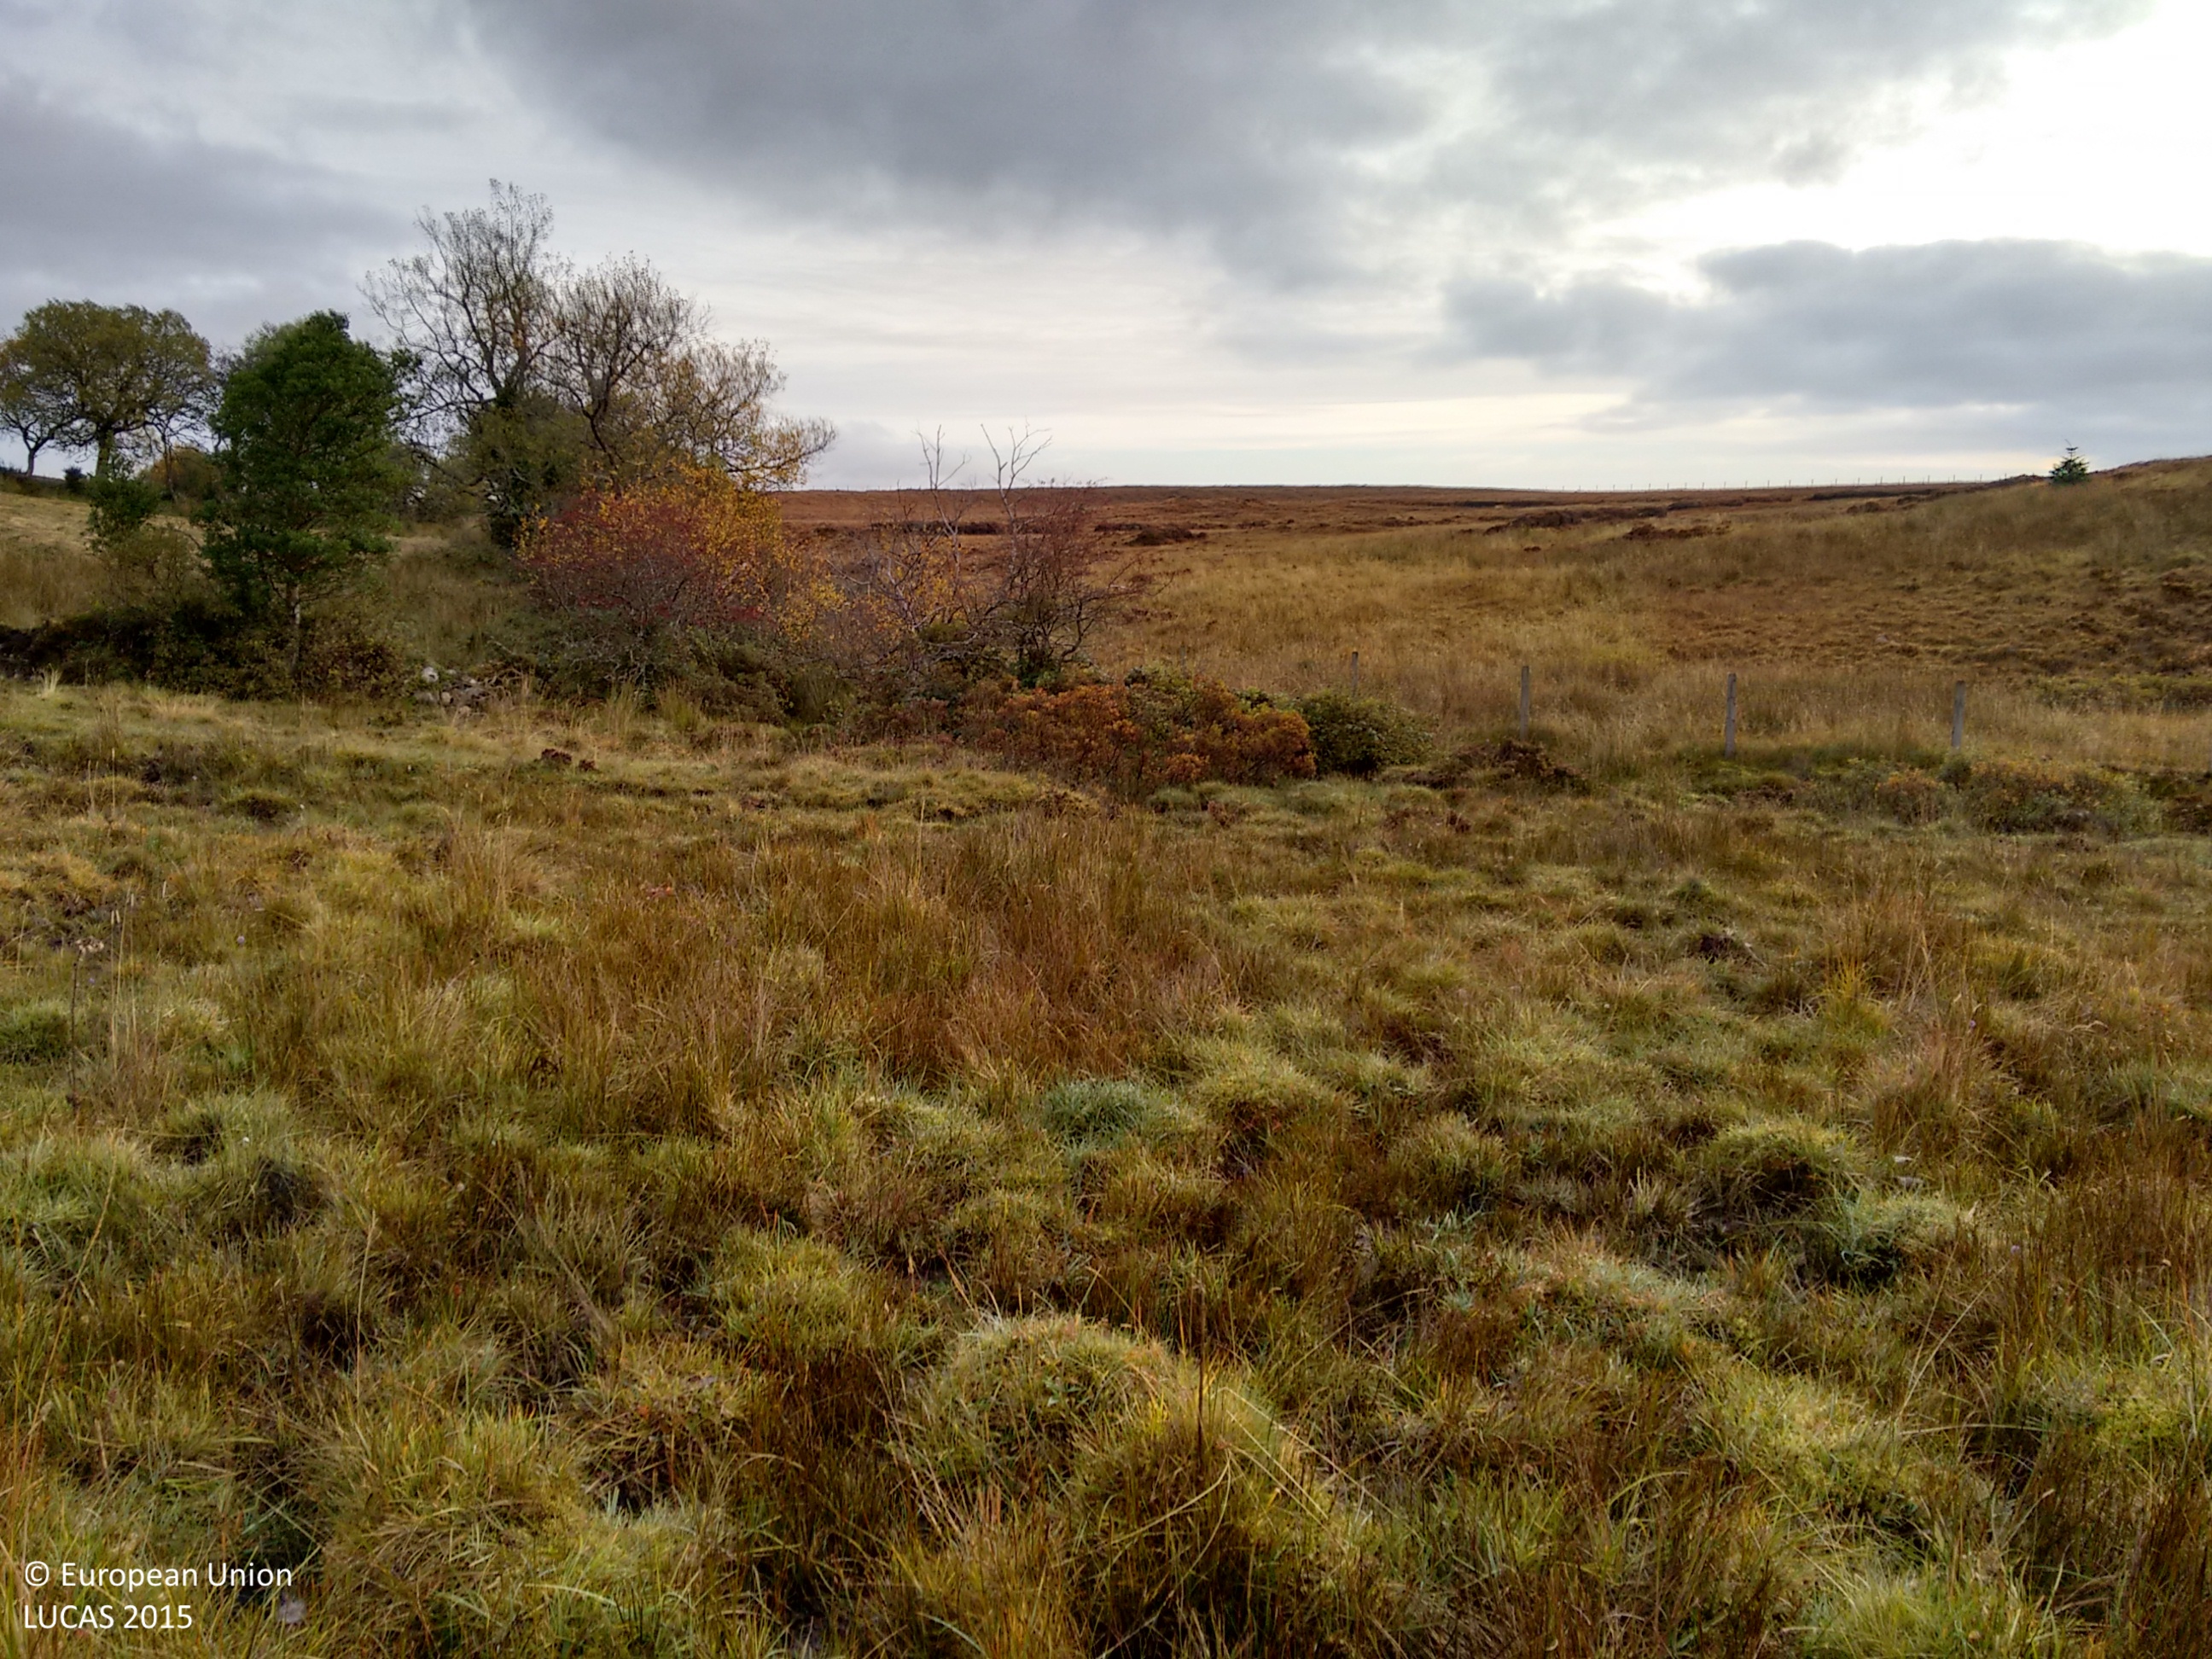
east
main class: Grassland
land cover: Grassland without tree/shrub cover
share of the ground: > 75 %
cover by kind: herbaceous plants 100 %
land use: Agriculture (excluding fallow land and kitchen gardens)
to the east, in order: Grassland without tree/shrub cover; Fences; Ditches and canals; Grass margins; Fences; Grassland without tree/shrub cover; Fences; Grassland without tree/shrub cover
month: October
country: GB
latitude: 54.5301
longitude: -7.9895
